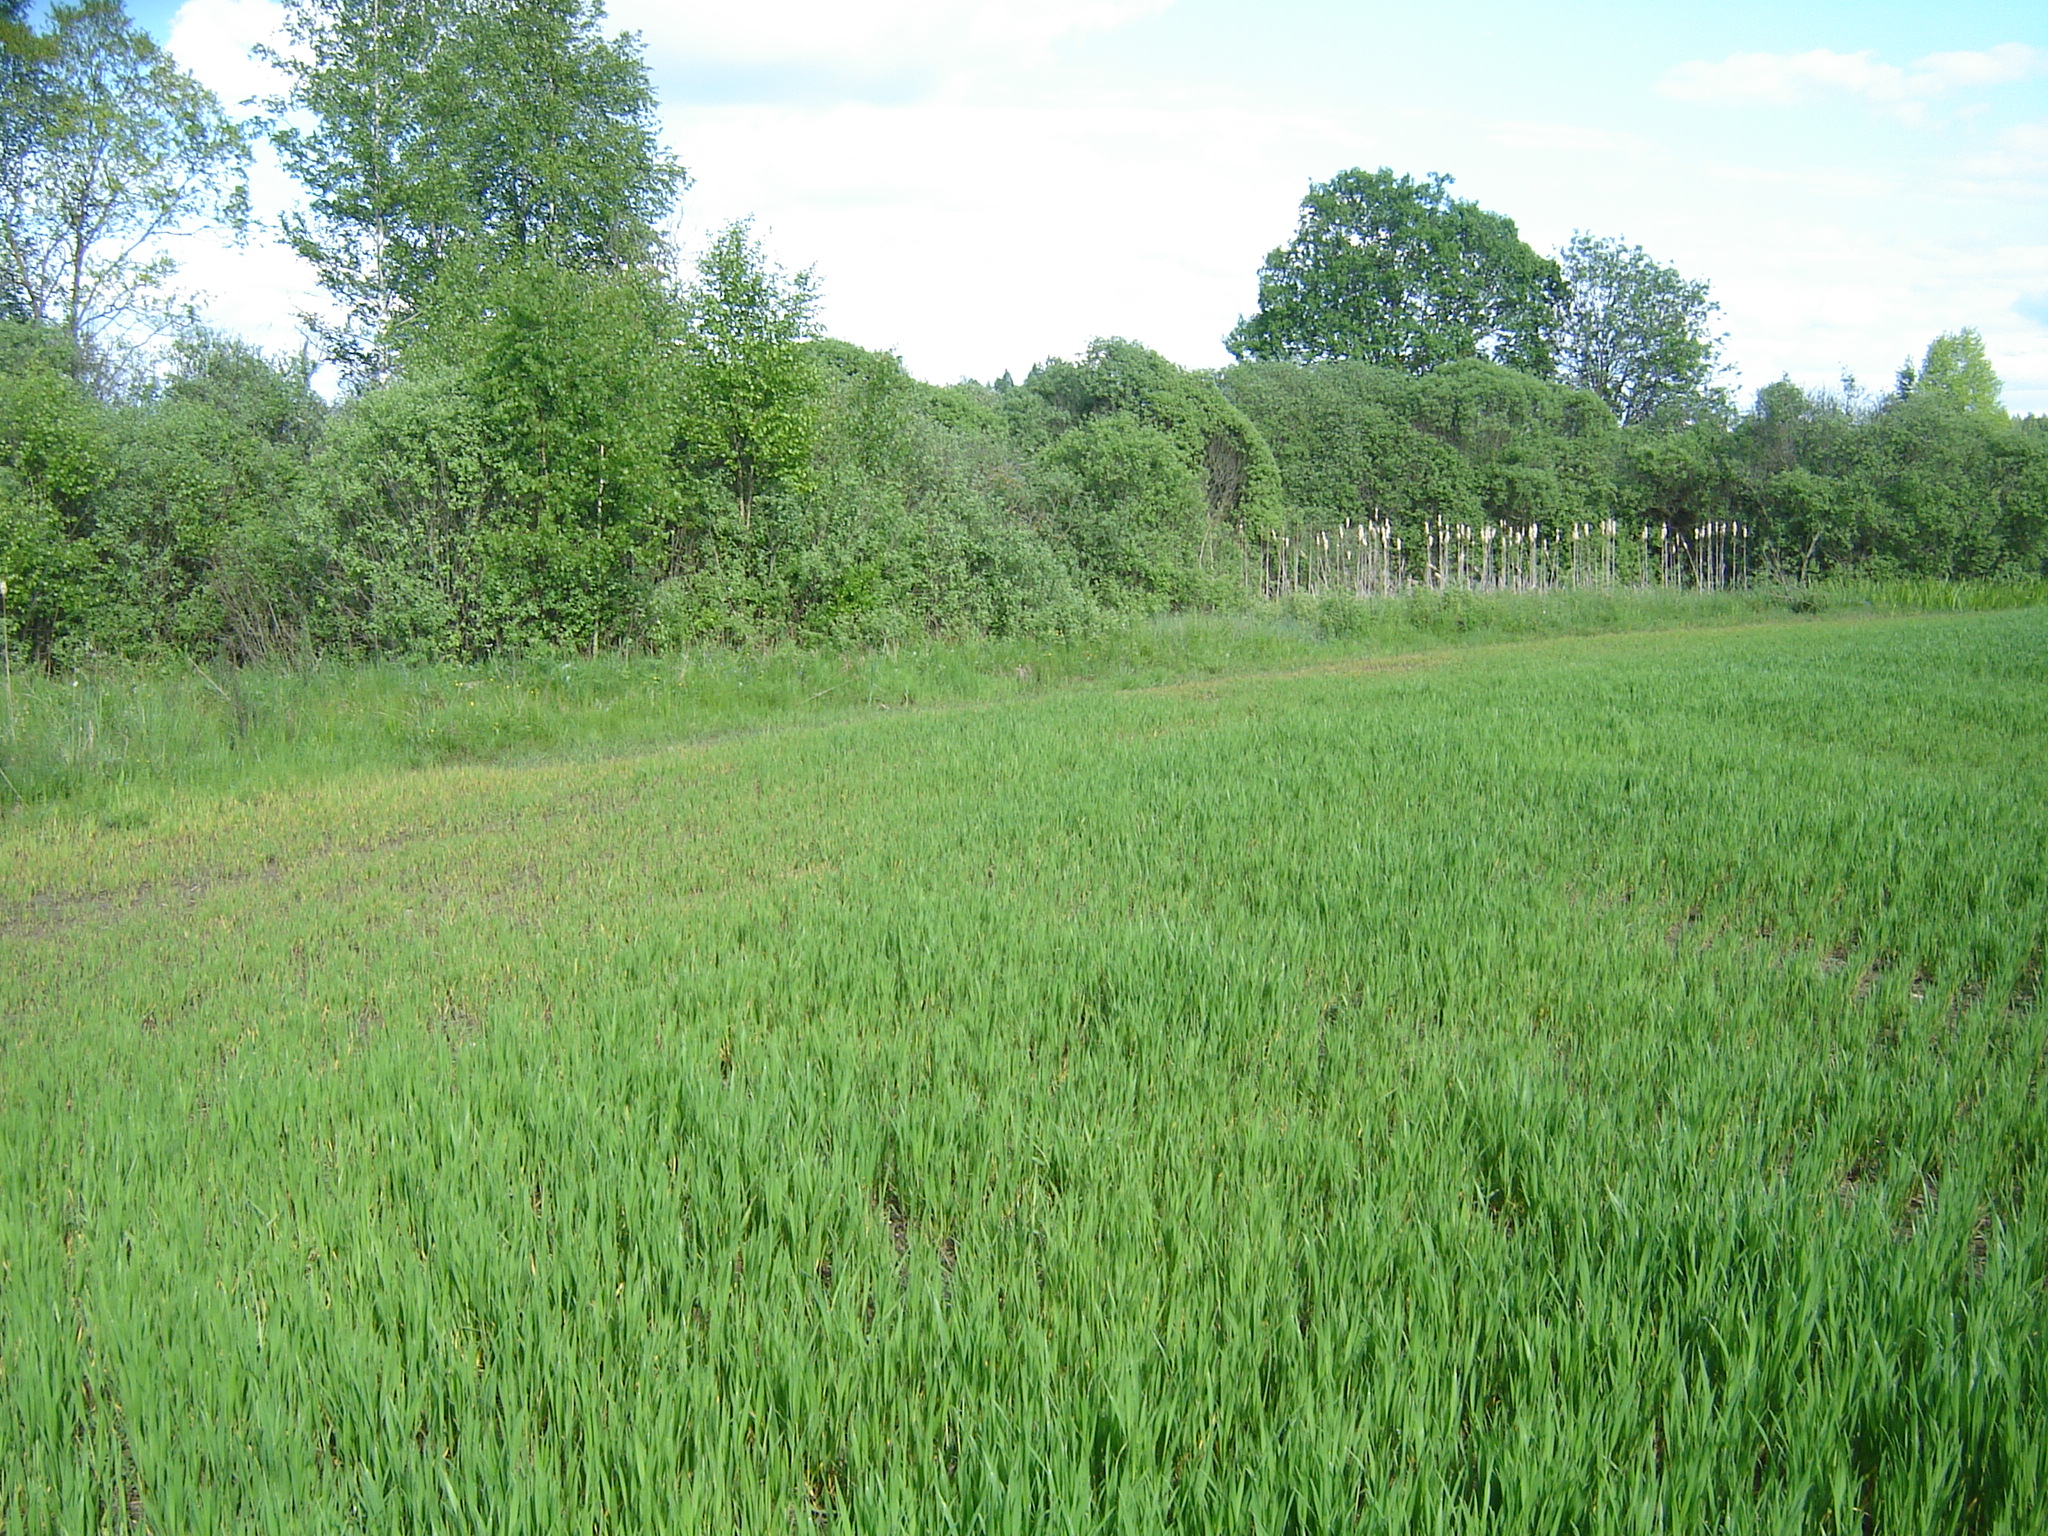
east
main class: Cropland
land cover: Barley
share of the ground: > 75 %
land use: Agriculture (excluding fallow land and kitchen gardens)
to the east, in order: Barley; Electric lines; Barley; Grass margins; Broadleaved woodland; Inland marshes; Broadleaved woodland; Barley
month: May
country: LT
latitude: 55.7295
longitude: 25.2280
